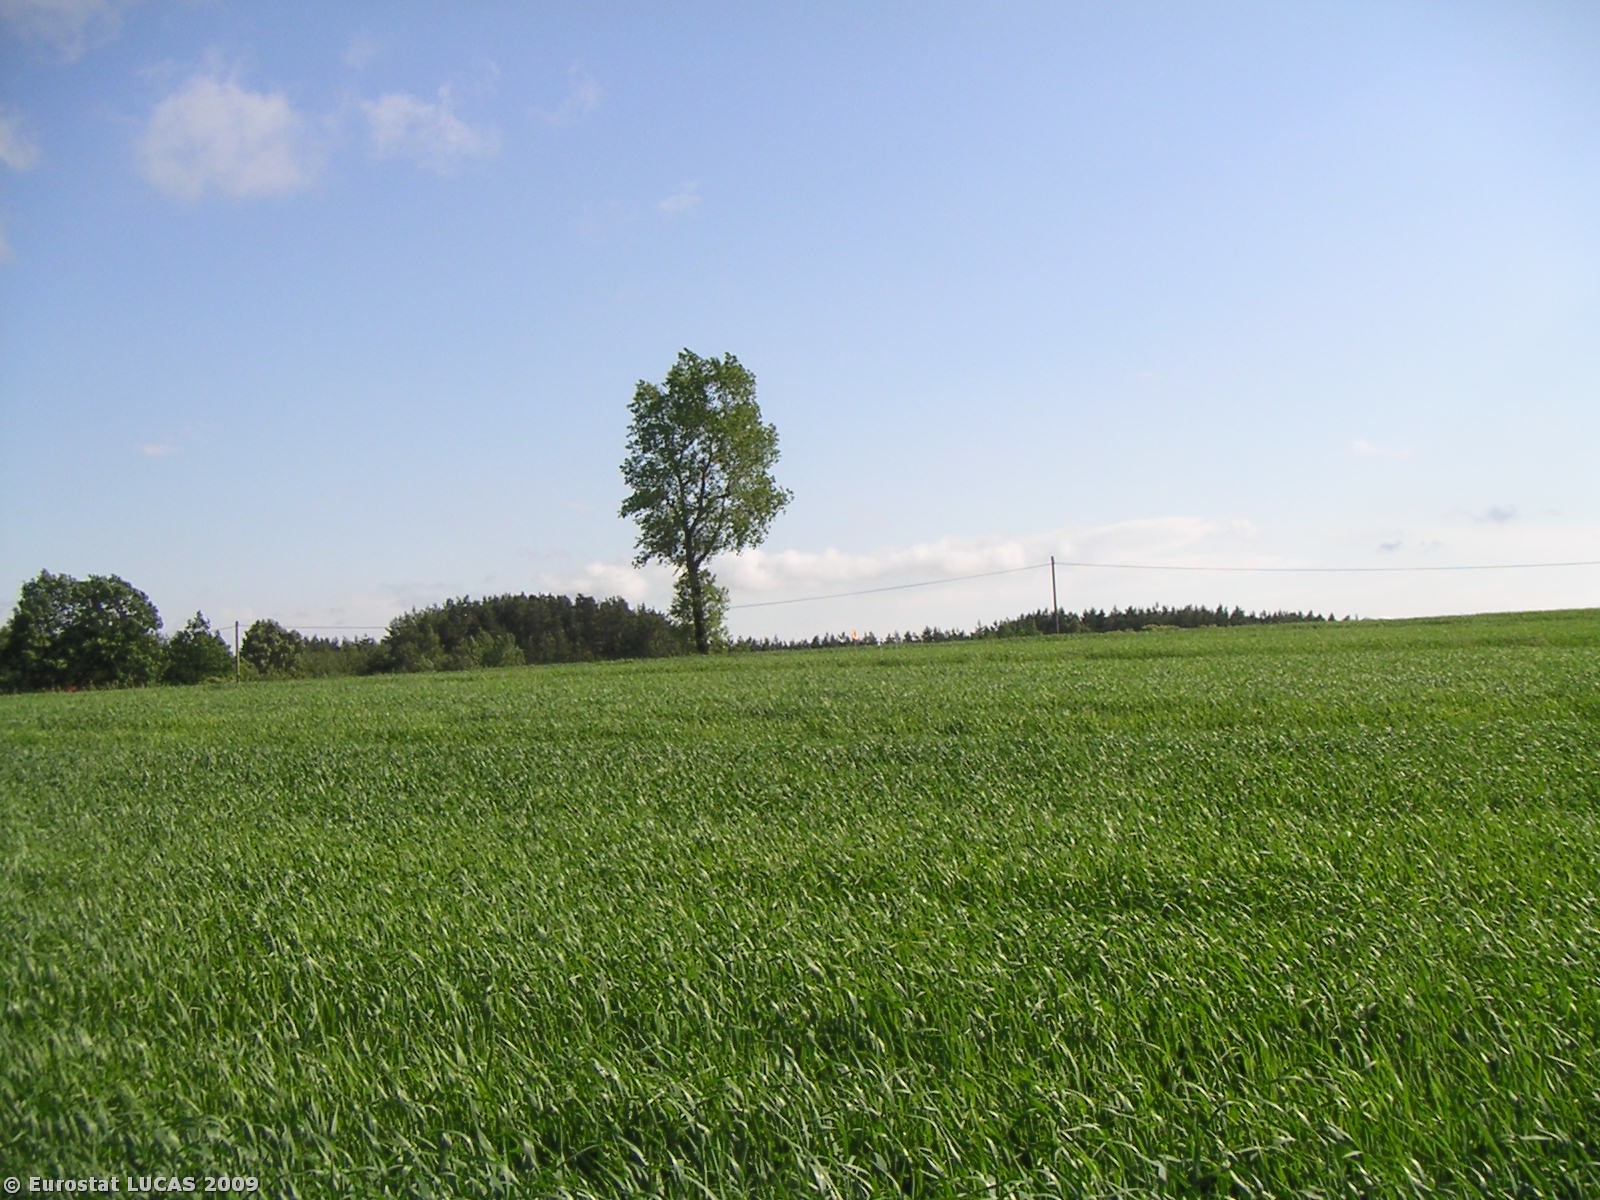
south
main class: Cropland
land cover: Oats
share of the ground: > 75 %
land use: Agriculture (excluding fallow land and kitchen gardens)
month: June
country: PL
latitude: 50.3234
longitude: 19.7922
